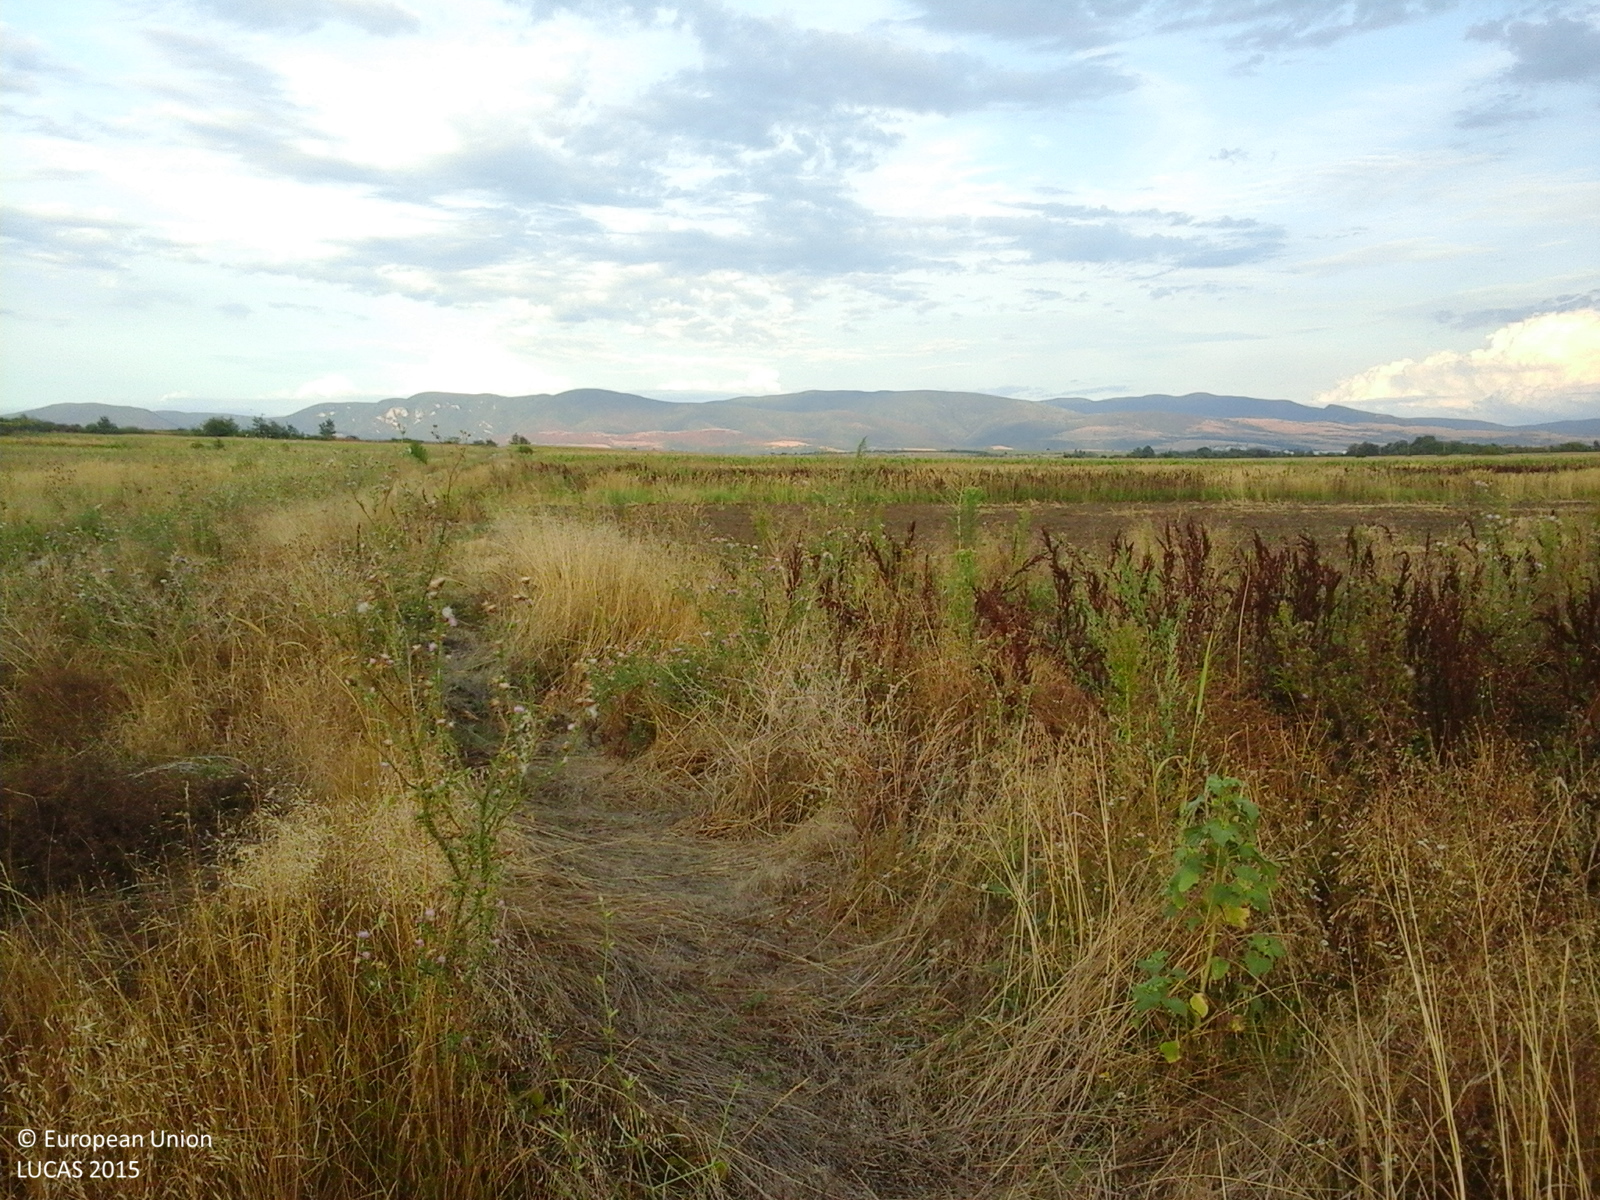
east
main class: Grassland
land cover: Spontaneously vegetated surfaces
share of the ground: > 75 %
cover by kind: herbaceous plants 100 %
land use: Fallow land
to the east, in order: Spontaneously vegetated surfaces; Common wheat; Spontaneously vegetated surfaces; Maize; Common wheat; Maize
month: August
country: RO
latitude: 44.9917
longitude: 21.5853
